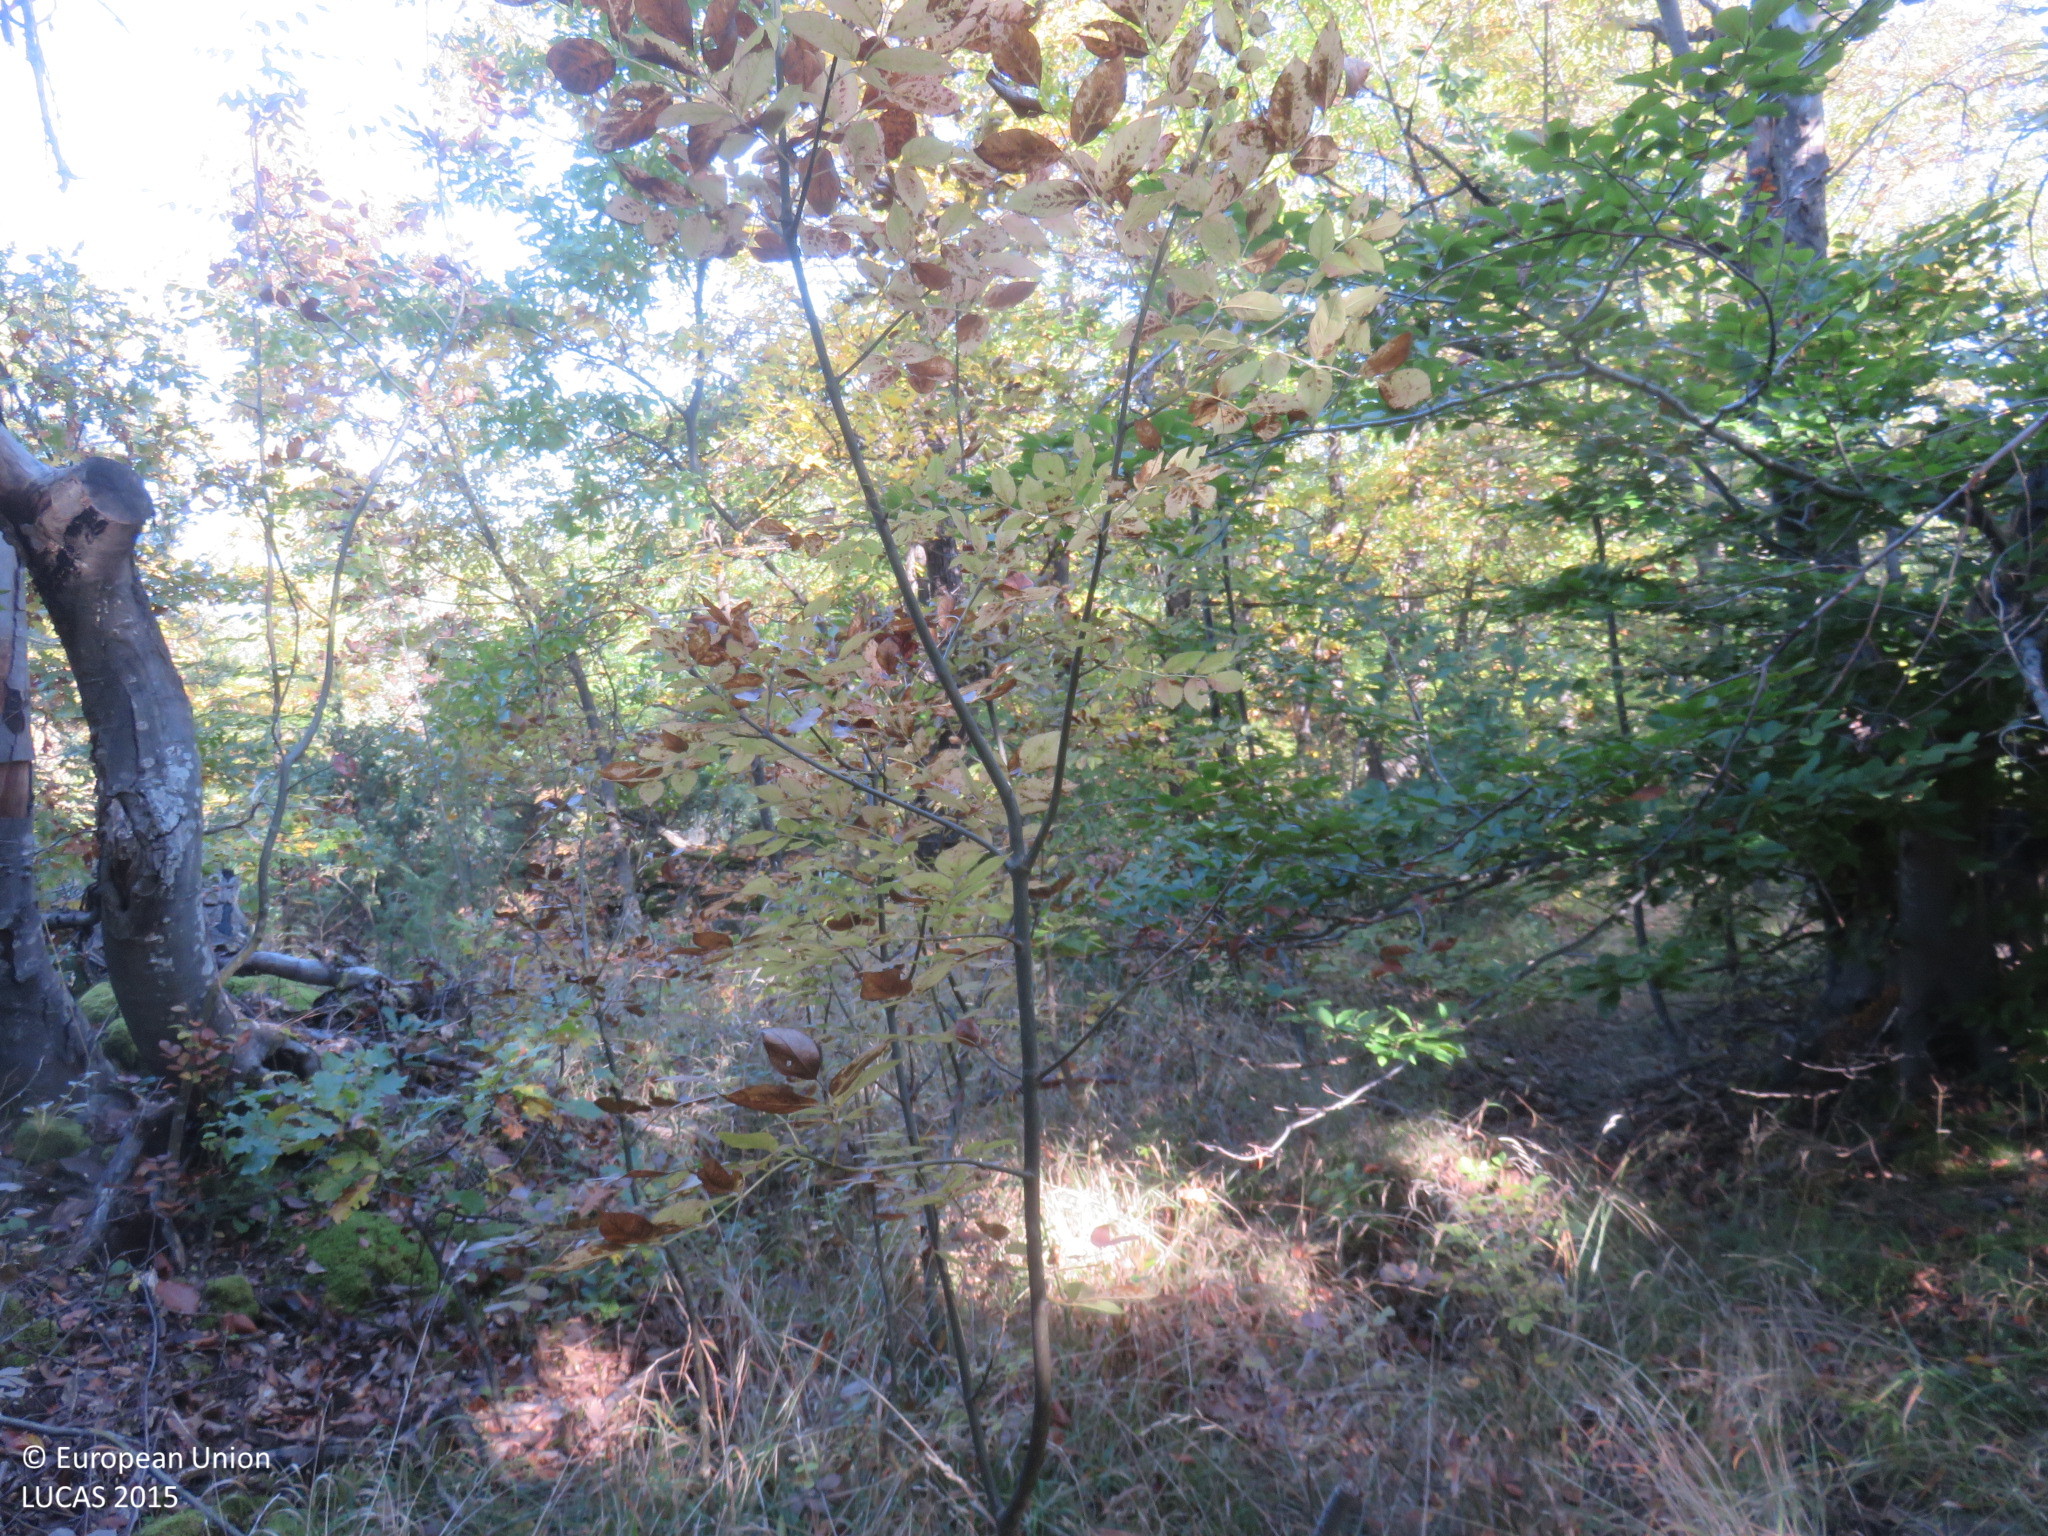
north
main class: Woodland
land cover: Broadleaved woodland
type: beech forest
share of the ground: > 75 %
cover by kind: broadleaved forest trees 95 %, unconsolidated bare surface 5 %
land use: Forestry
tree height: > 5 m
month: October
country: BG
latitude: 42.8739
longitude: 24.8371
